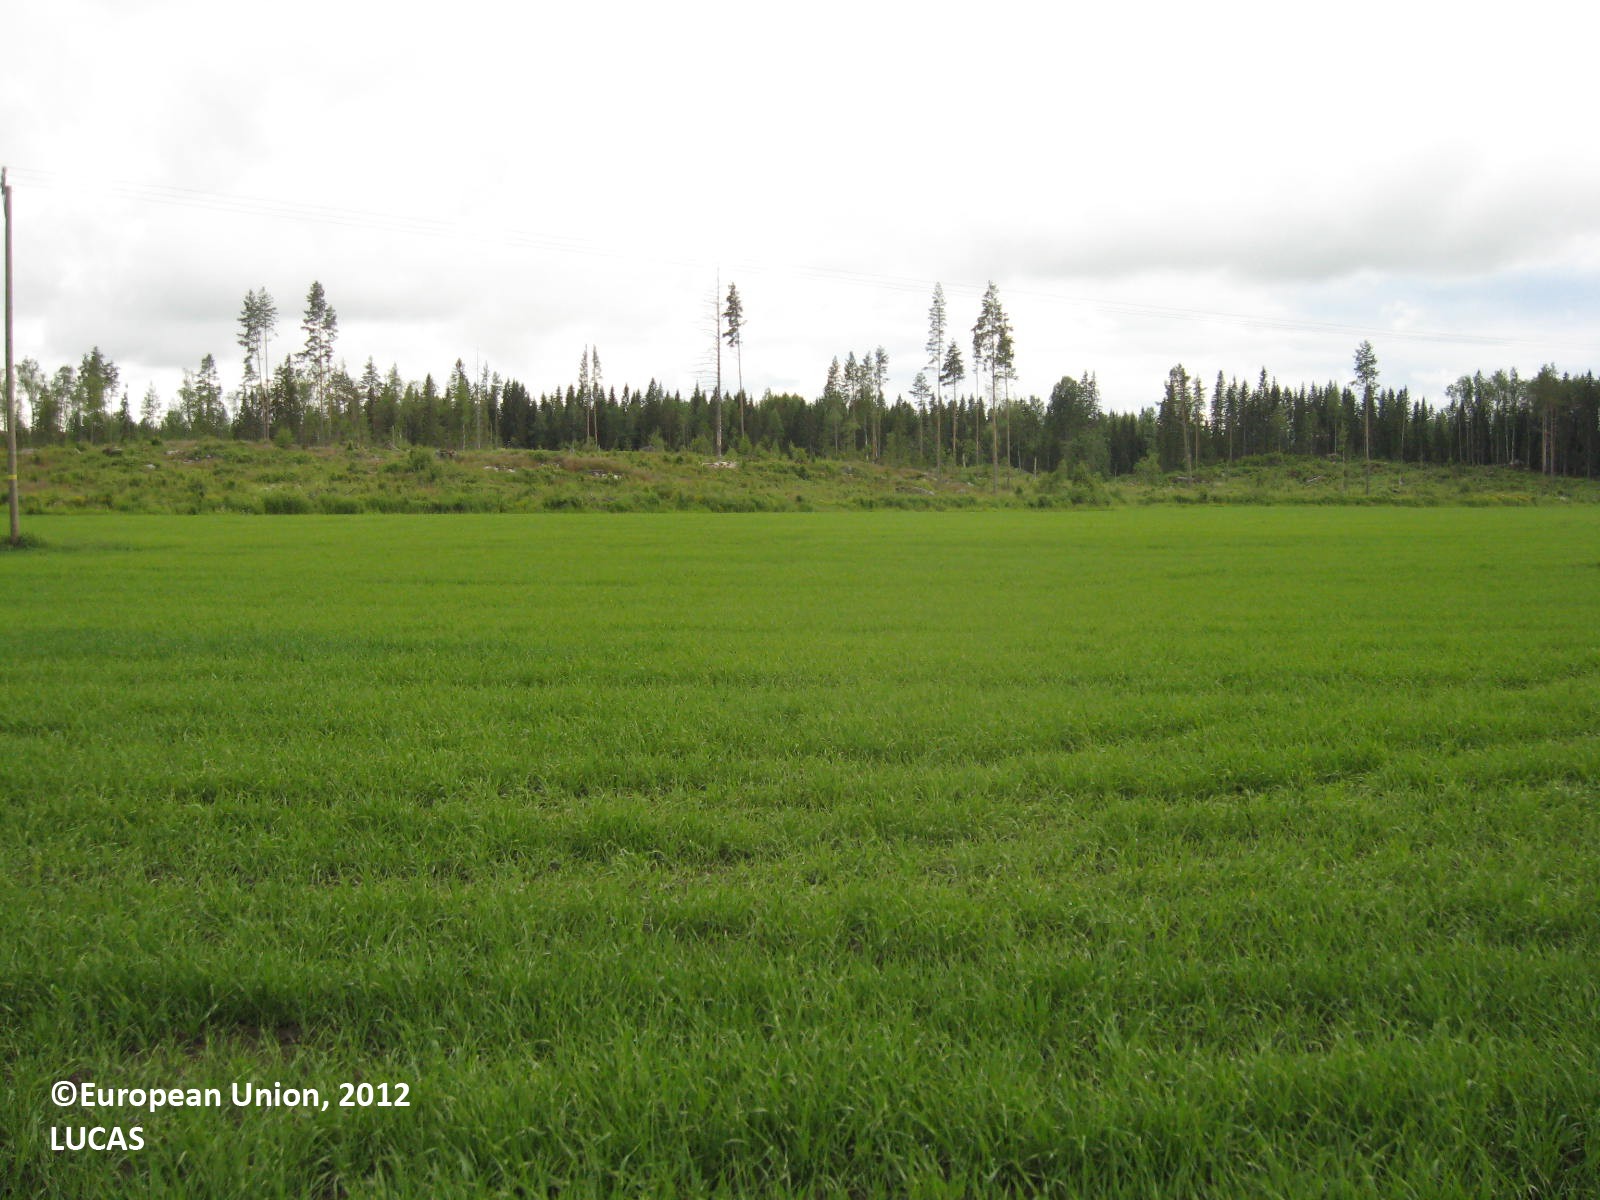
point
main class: Cropland
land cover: Barley
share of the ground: > 75 %
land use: Agriculture (excluding fallow land and kitchen gardens)
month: June
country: FI
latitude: 62.9197
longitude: 22.6358
